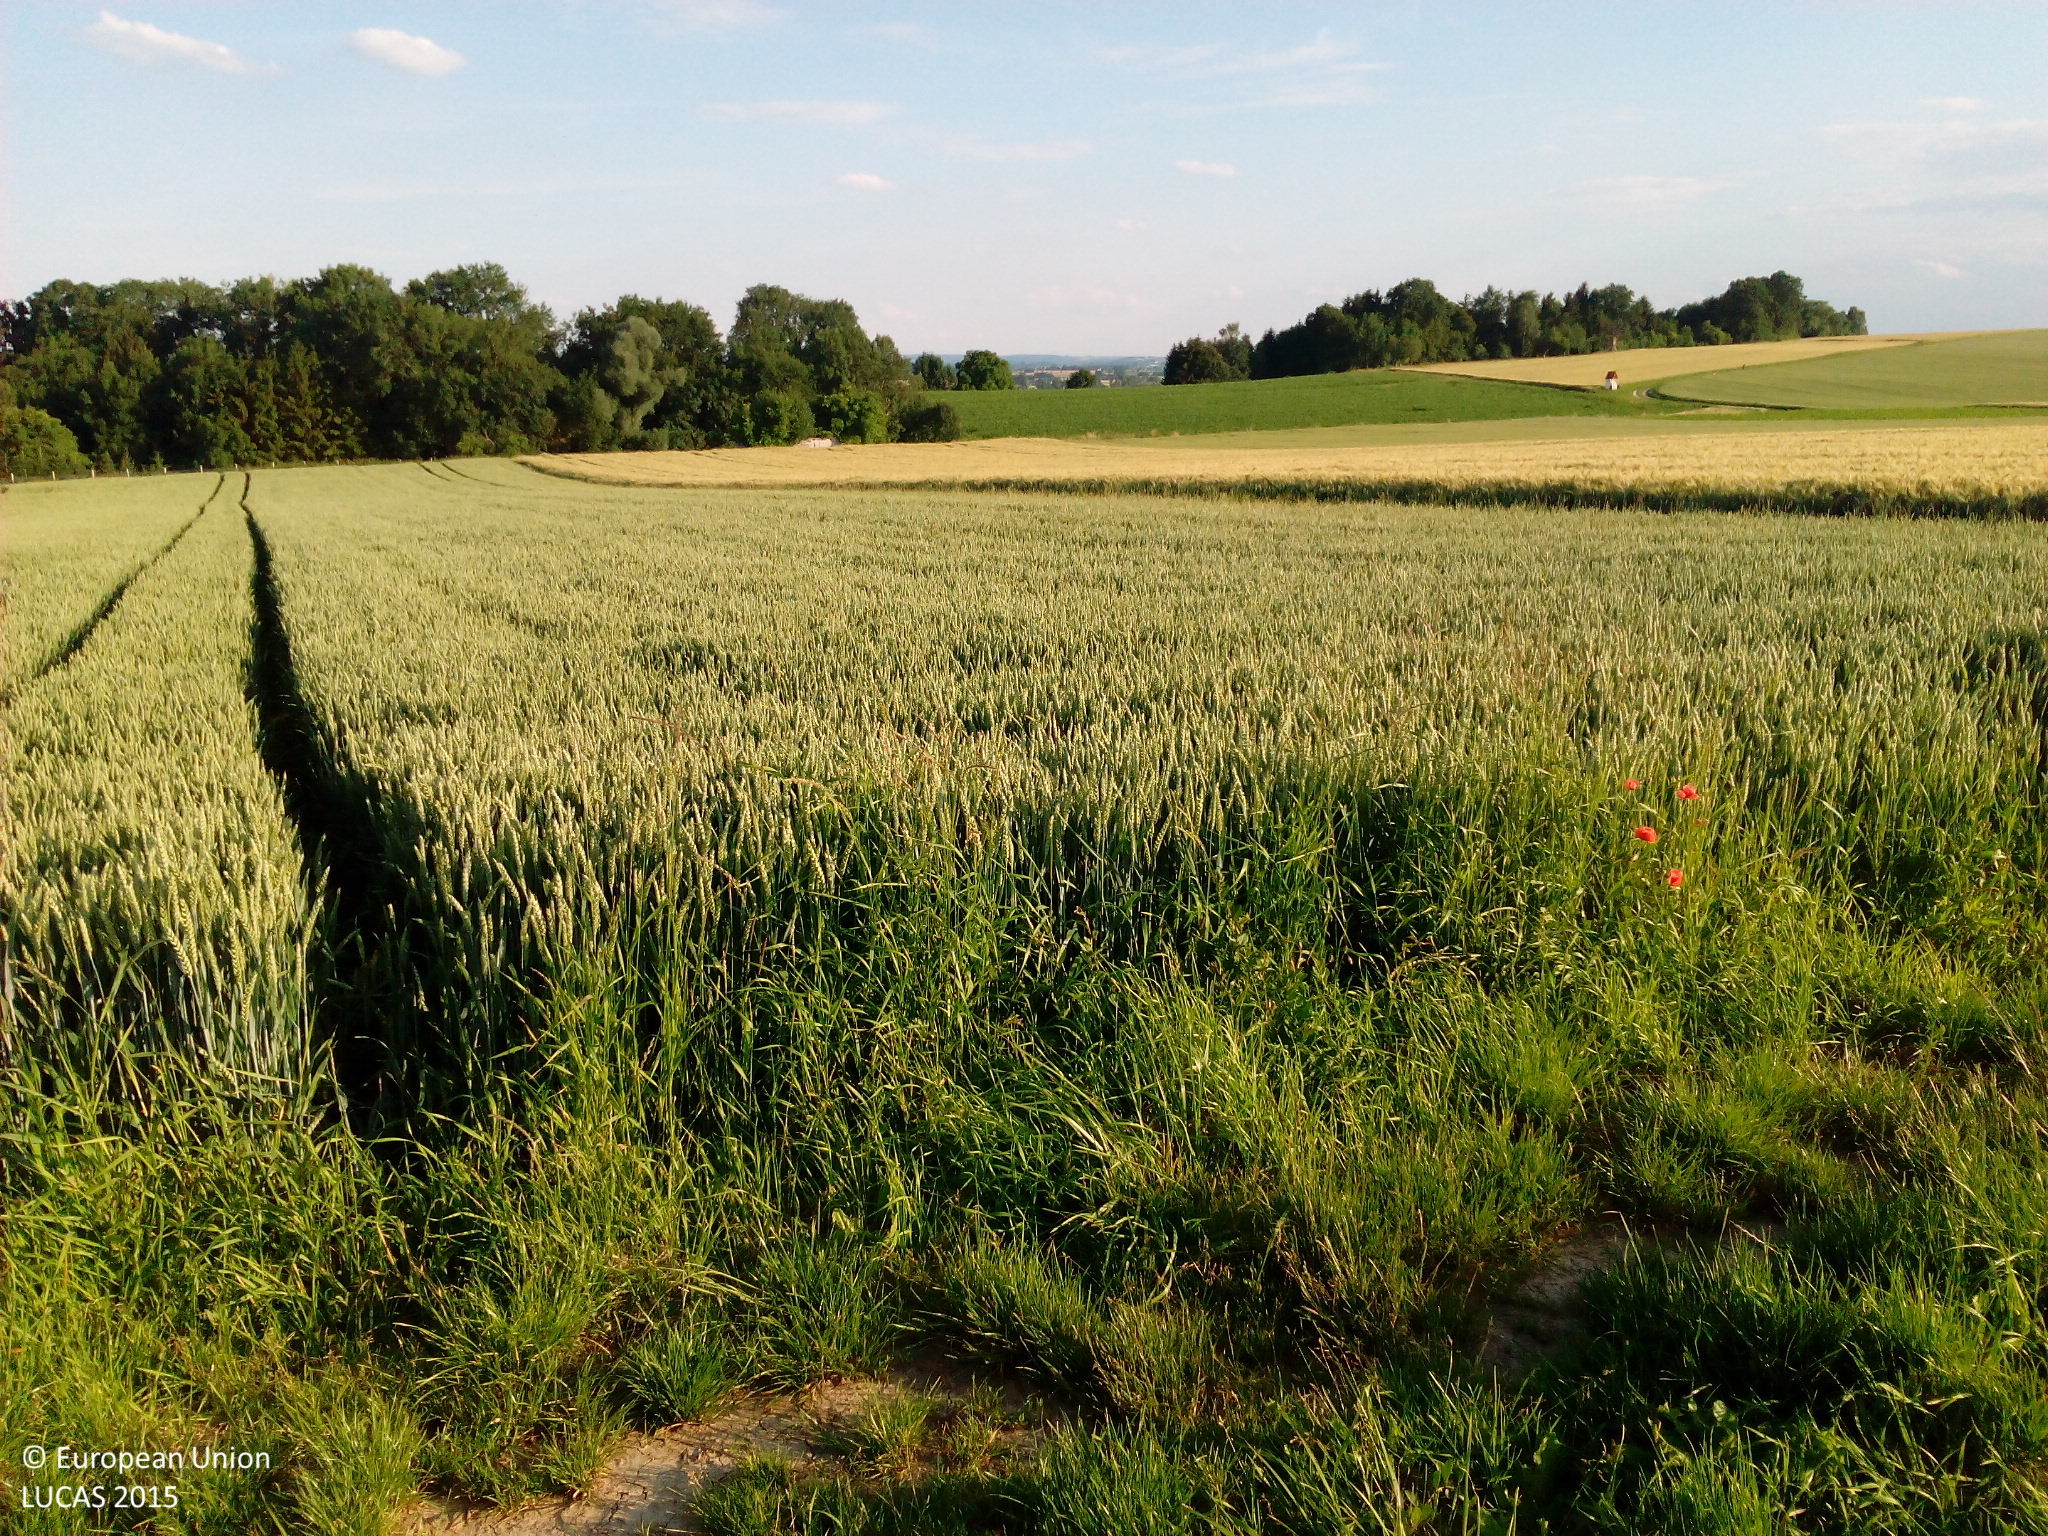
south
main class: Cropland
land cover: Common wheat
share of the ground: > 75 %
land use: Agriculture (excluding fallow land and kitchen gardens)
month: June
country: DE
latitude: 48.3134
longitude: 9.8518
